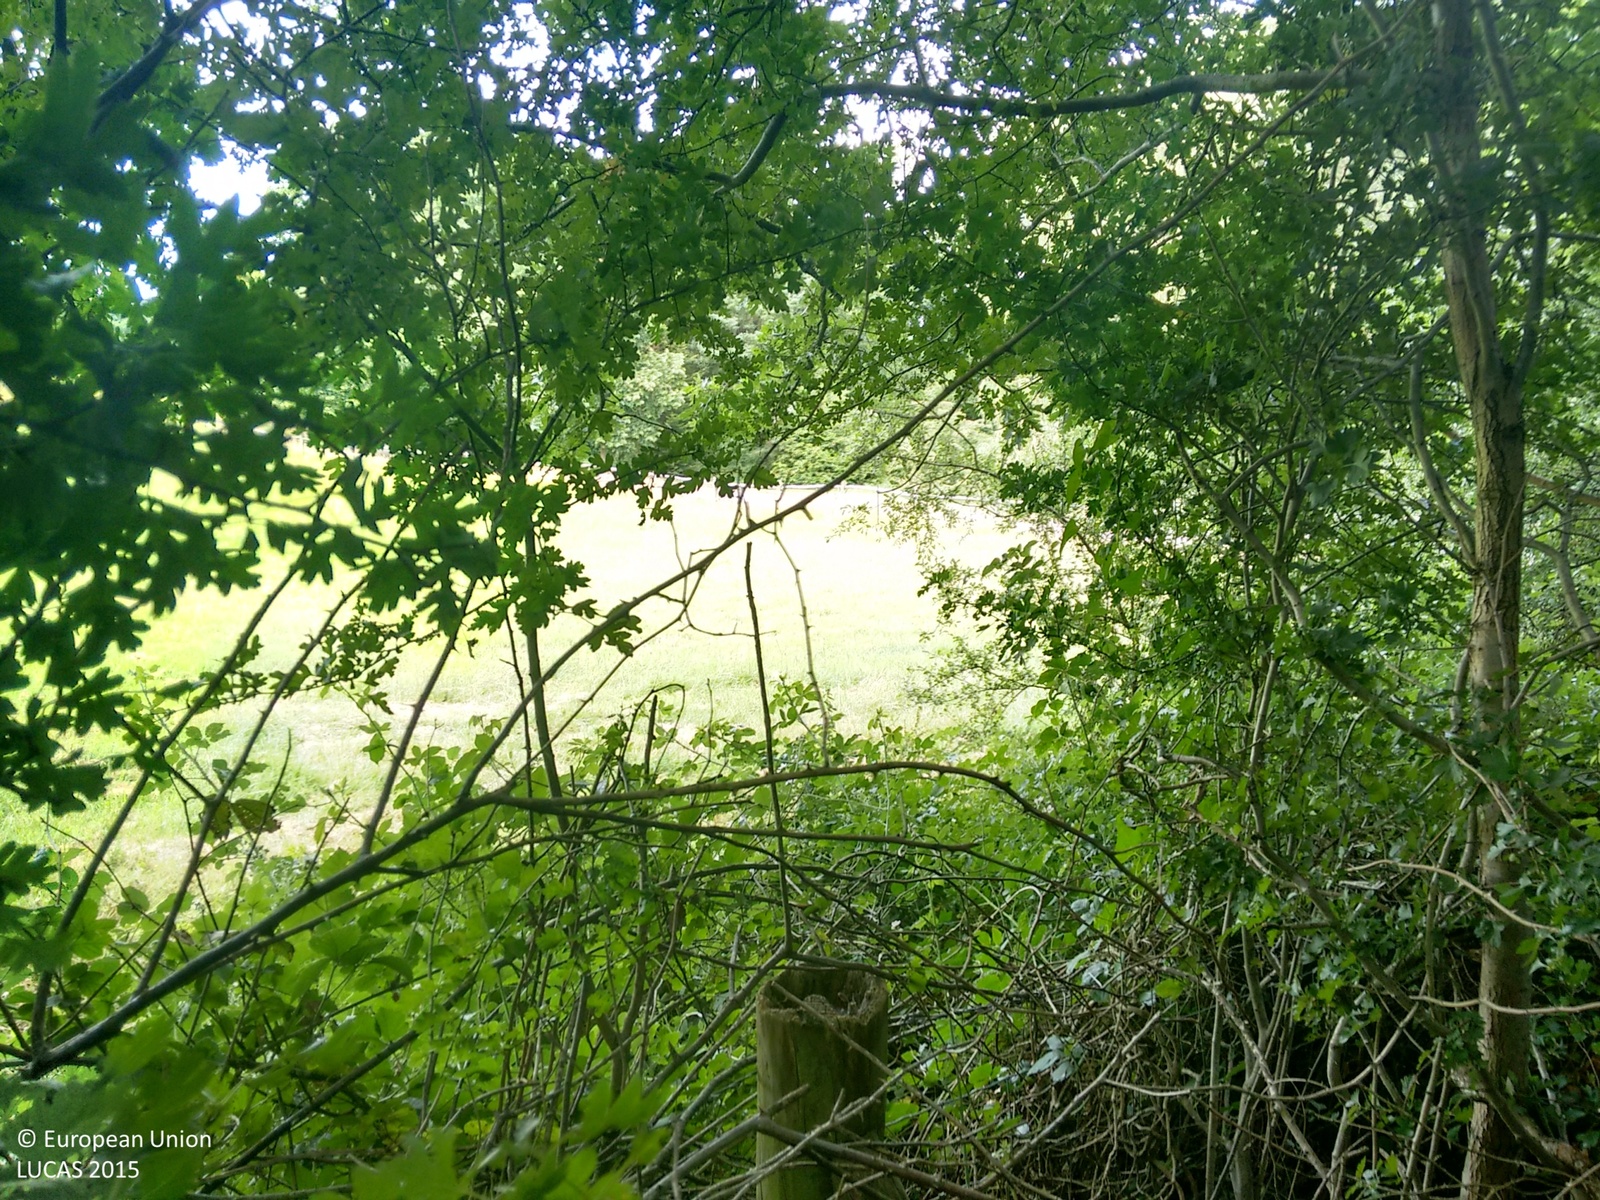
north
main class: Woodland
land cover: Broadleaved woodland
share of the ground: > 75 %
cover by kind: broadleaved forest trees 100 %
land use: Agriculture (excluding fallow land and kitchen gardens)
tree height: > 5 m
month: July
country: GB
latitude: 51.0204
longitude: -0.5166
